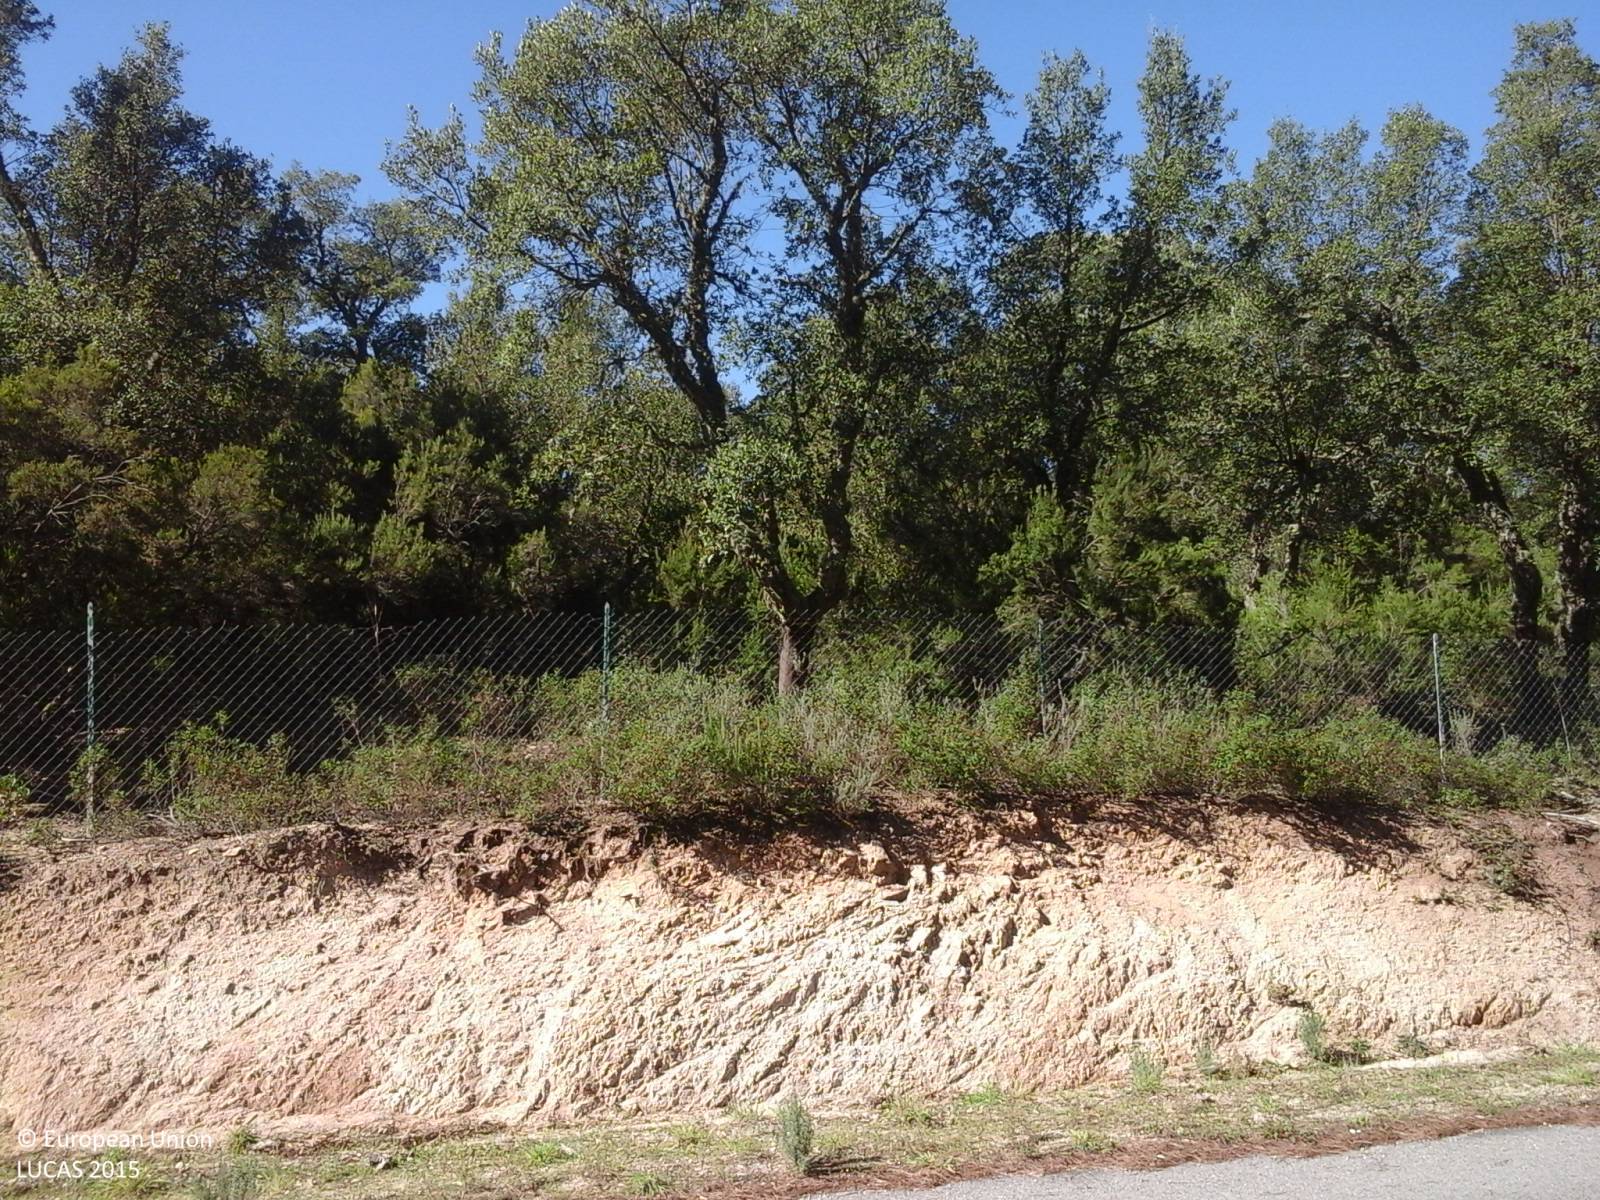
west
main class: Grassland
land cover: Grassland with sparse tree/shrub cover
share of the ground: > 75 %
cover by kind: herbaceous plants 90 %, broadleaved forest trees 5 %, shrubs 5 %
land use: Semi-natural and natural areas not in use
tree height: < 5 m
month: October
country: IT
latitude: 40.1001
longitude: 9.0783
